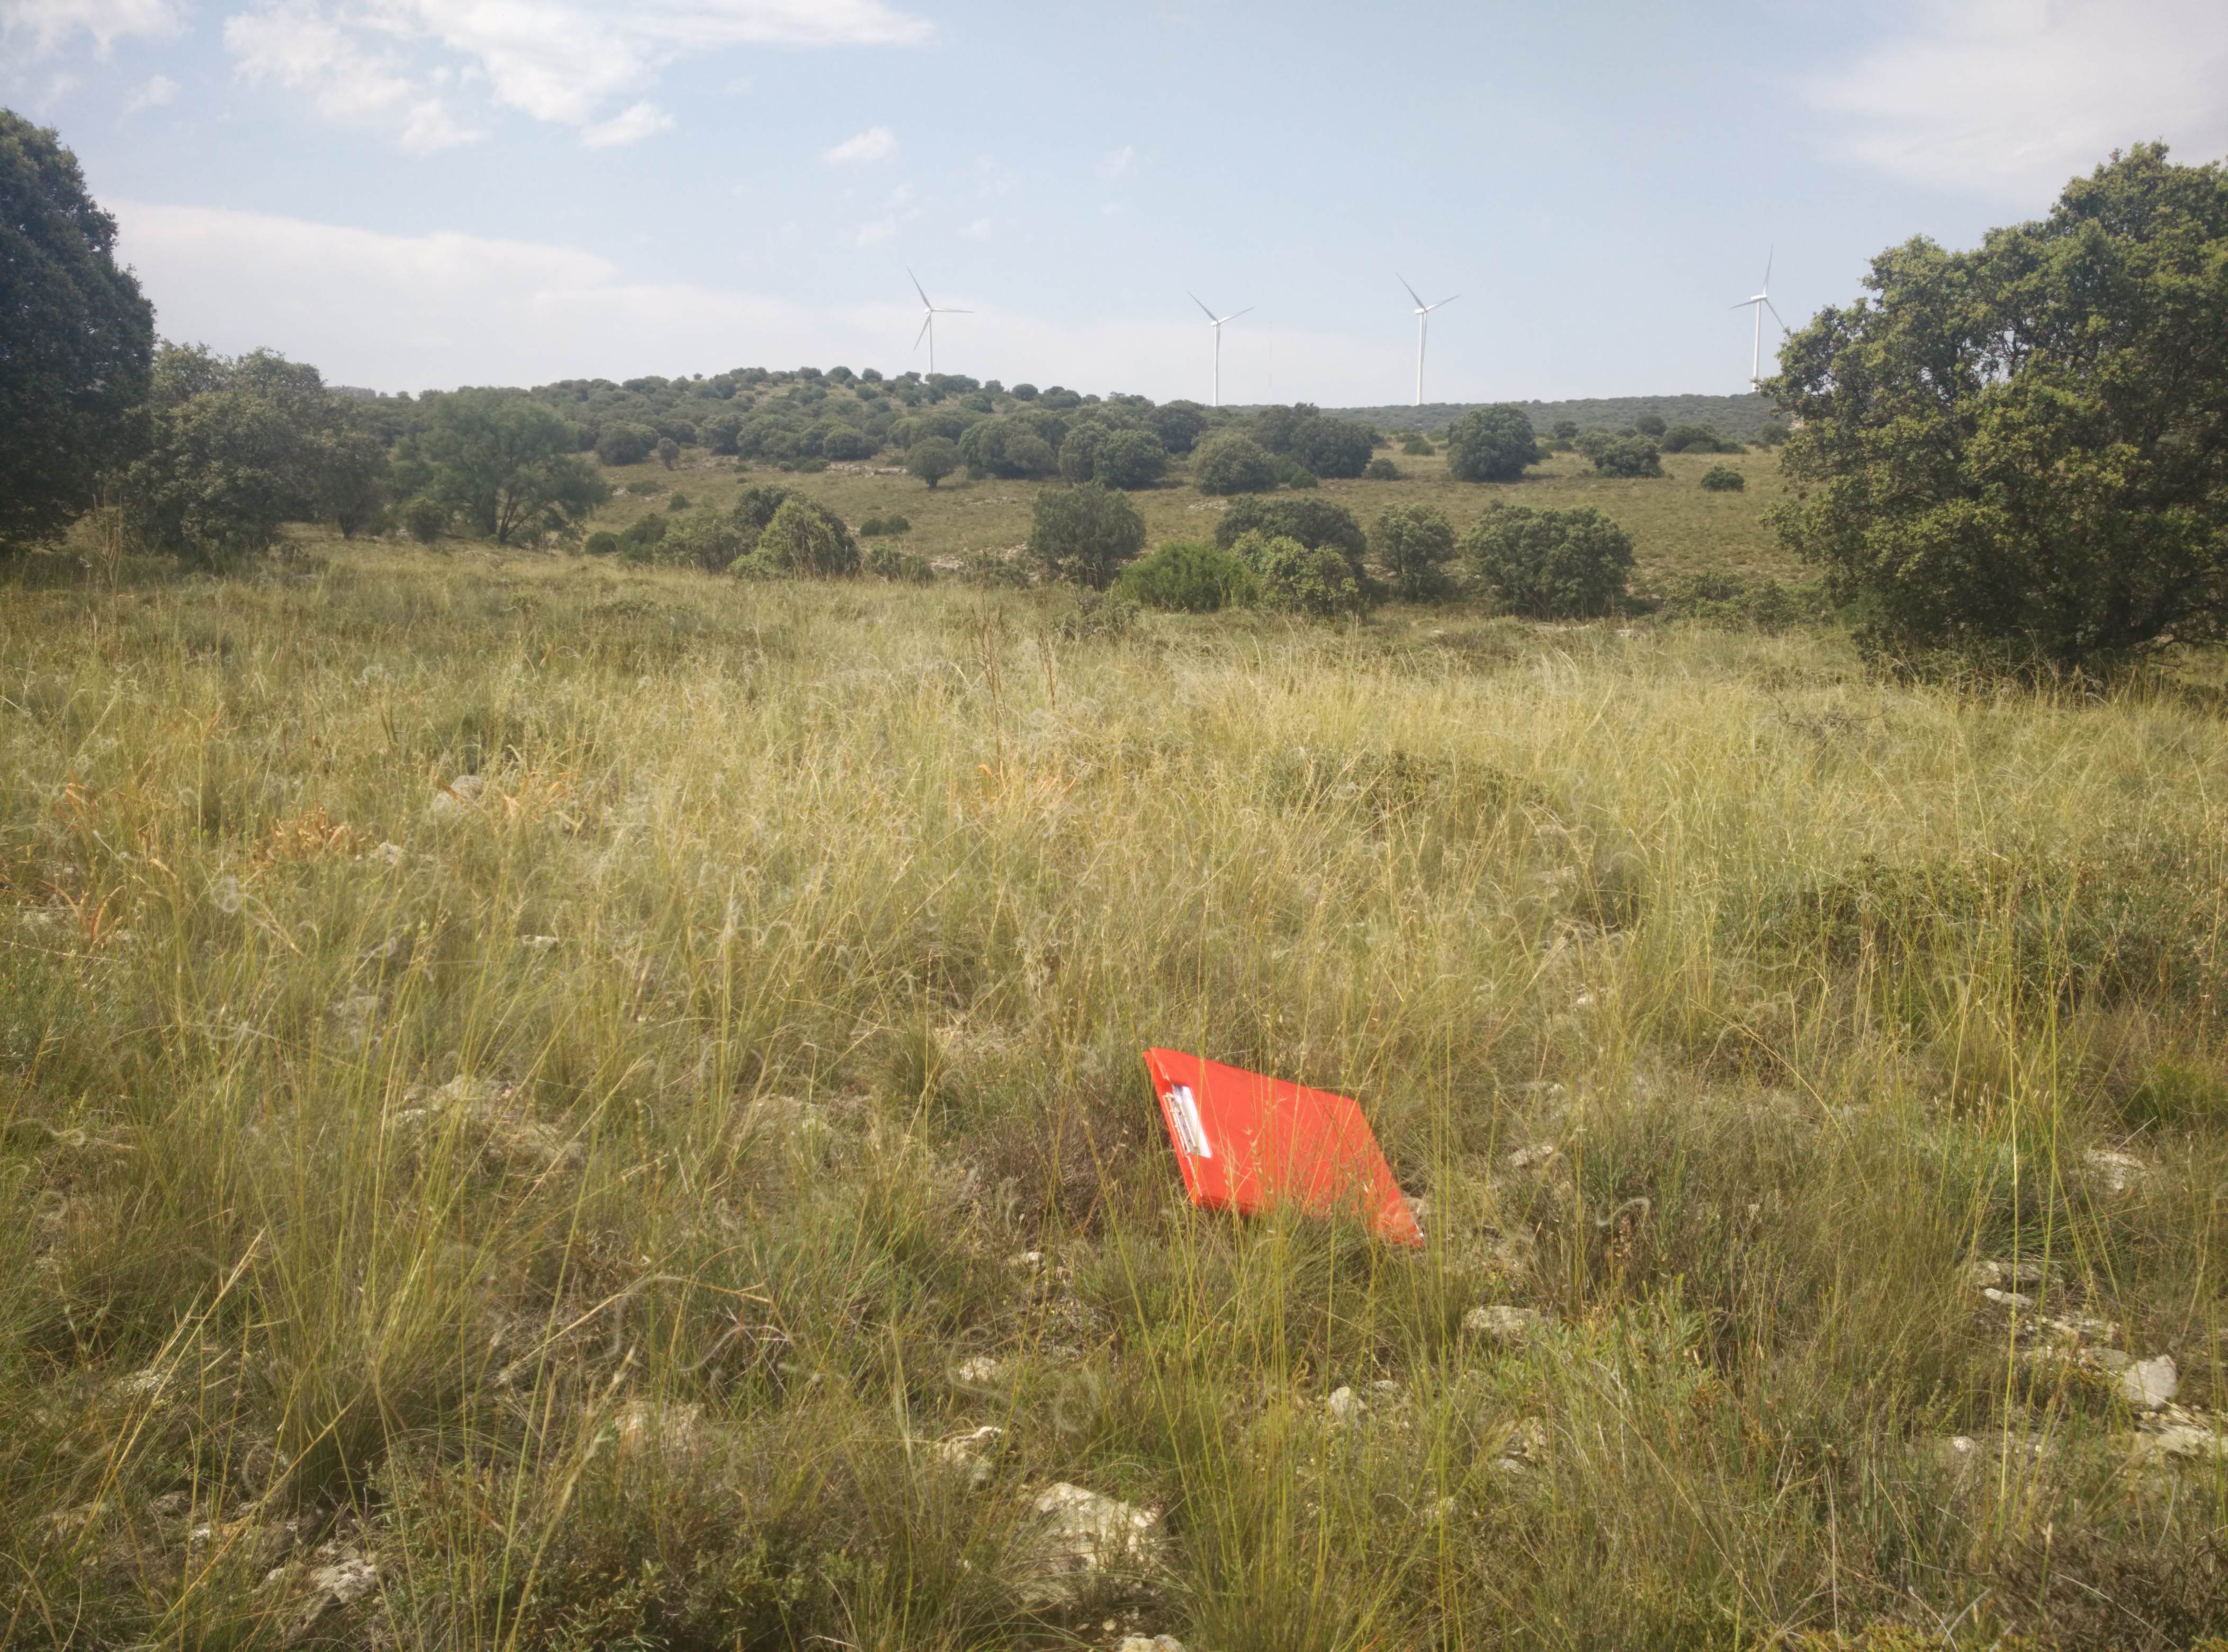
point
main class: Shrubland
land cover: Shrubland with sparse tree cover
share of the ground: > 75 %
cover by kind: shrubs 90 %, broadleaved forest trees 5 %, unconsolidated bare surface 5 %
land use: Semi-natural and natural areas not in use
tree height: < 5 m
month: July
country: ES
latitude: 41.0302
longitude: -1.8104
